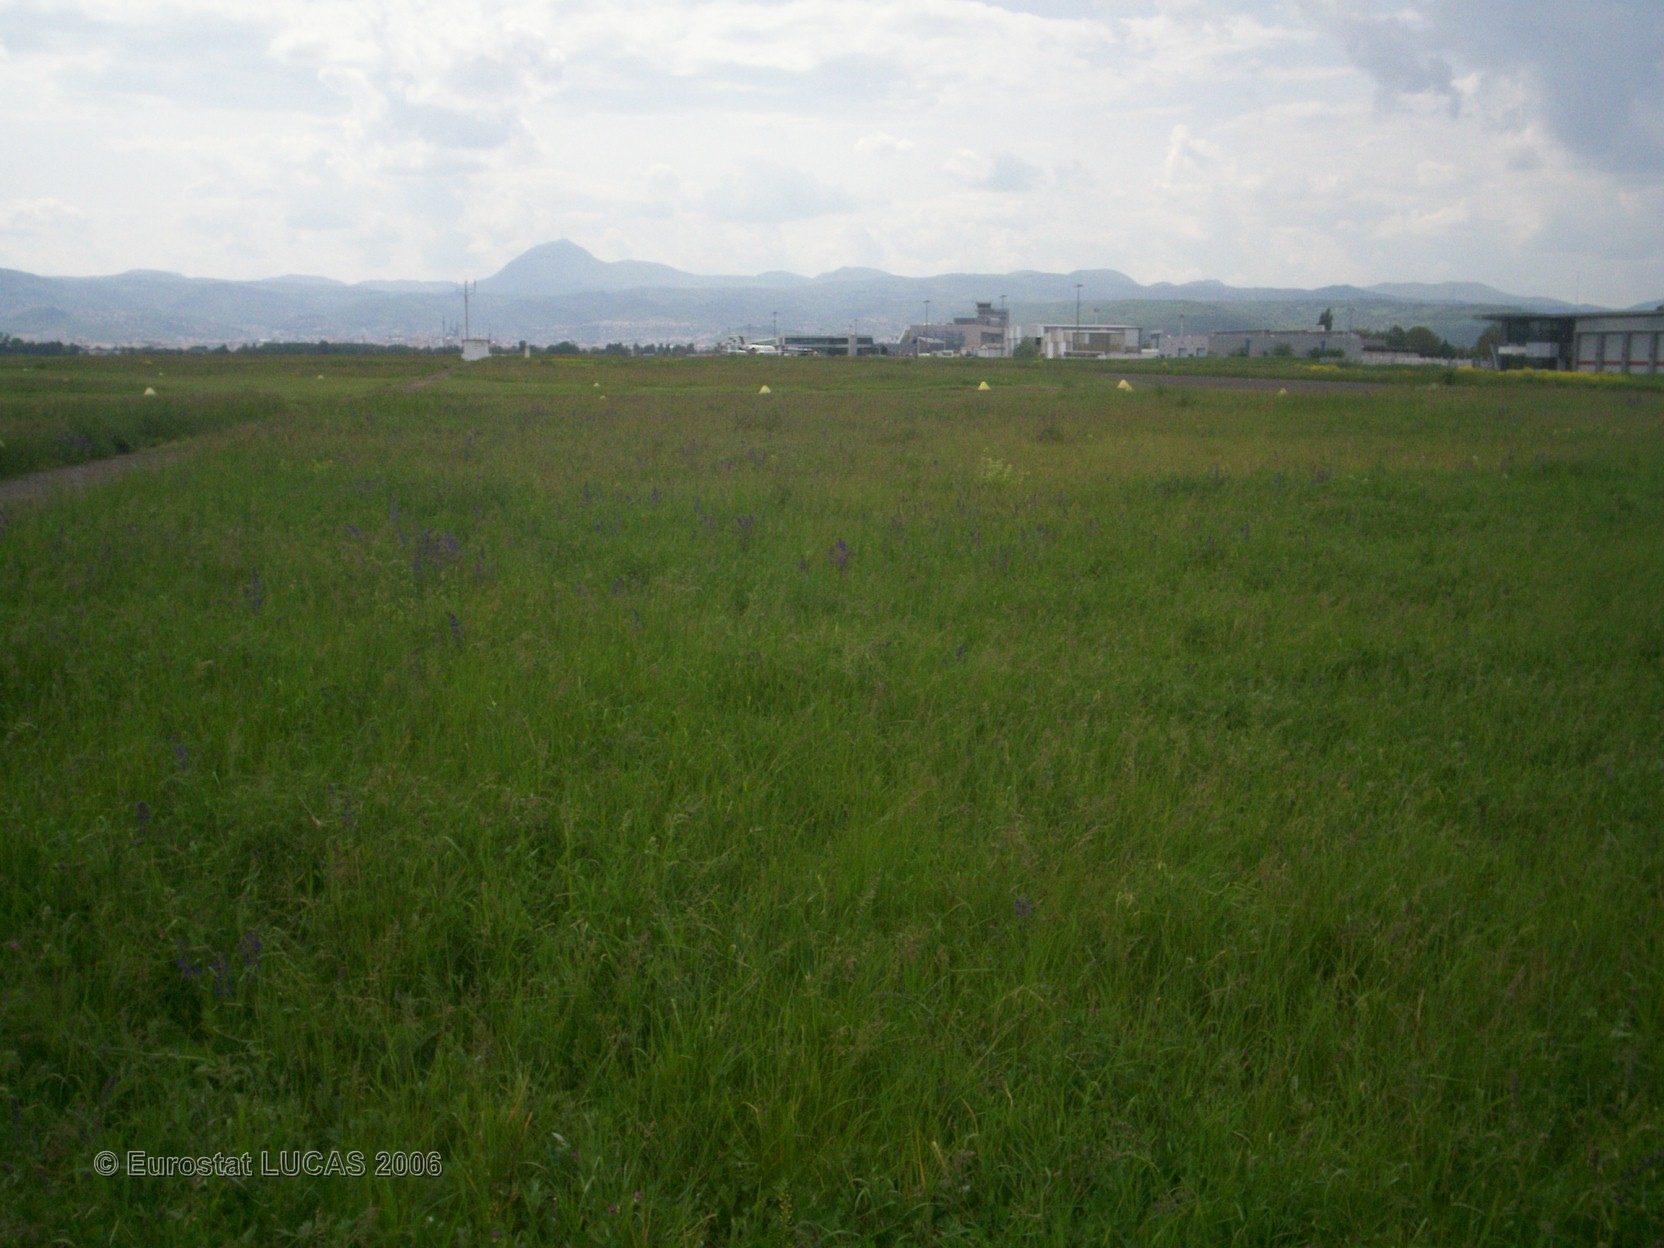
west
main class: Grassland
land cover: Grassland without tree/shrub cover
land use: Air transport
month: May
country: FR
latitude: 45.7893
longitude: 3.1693
